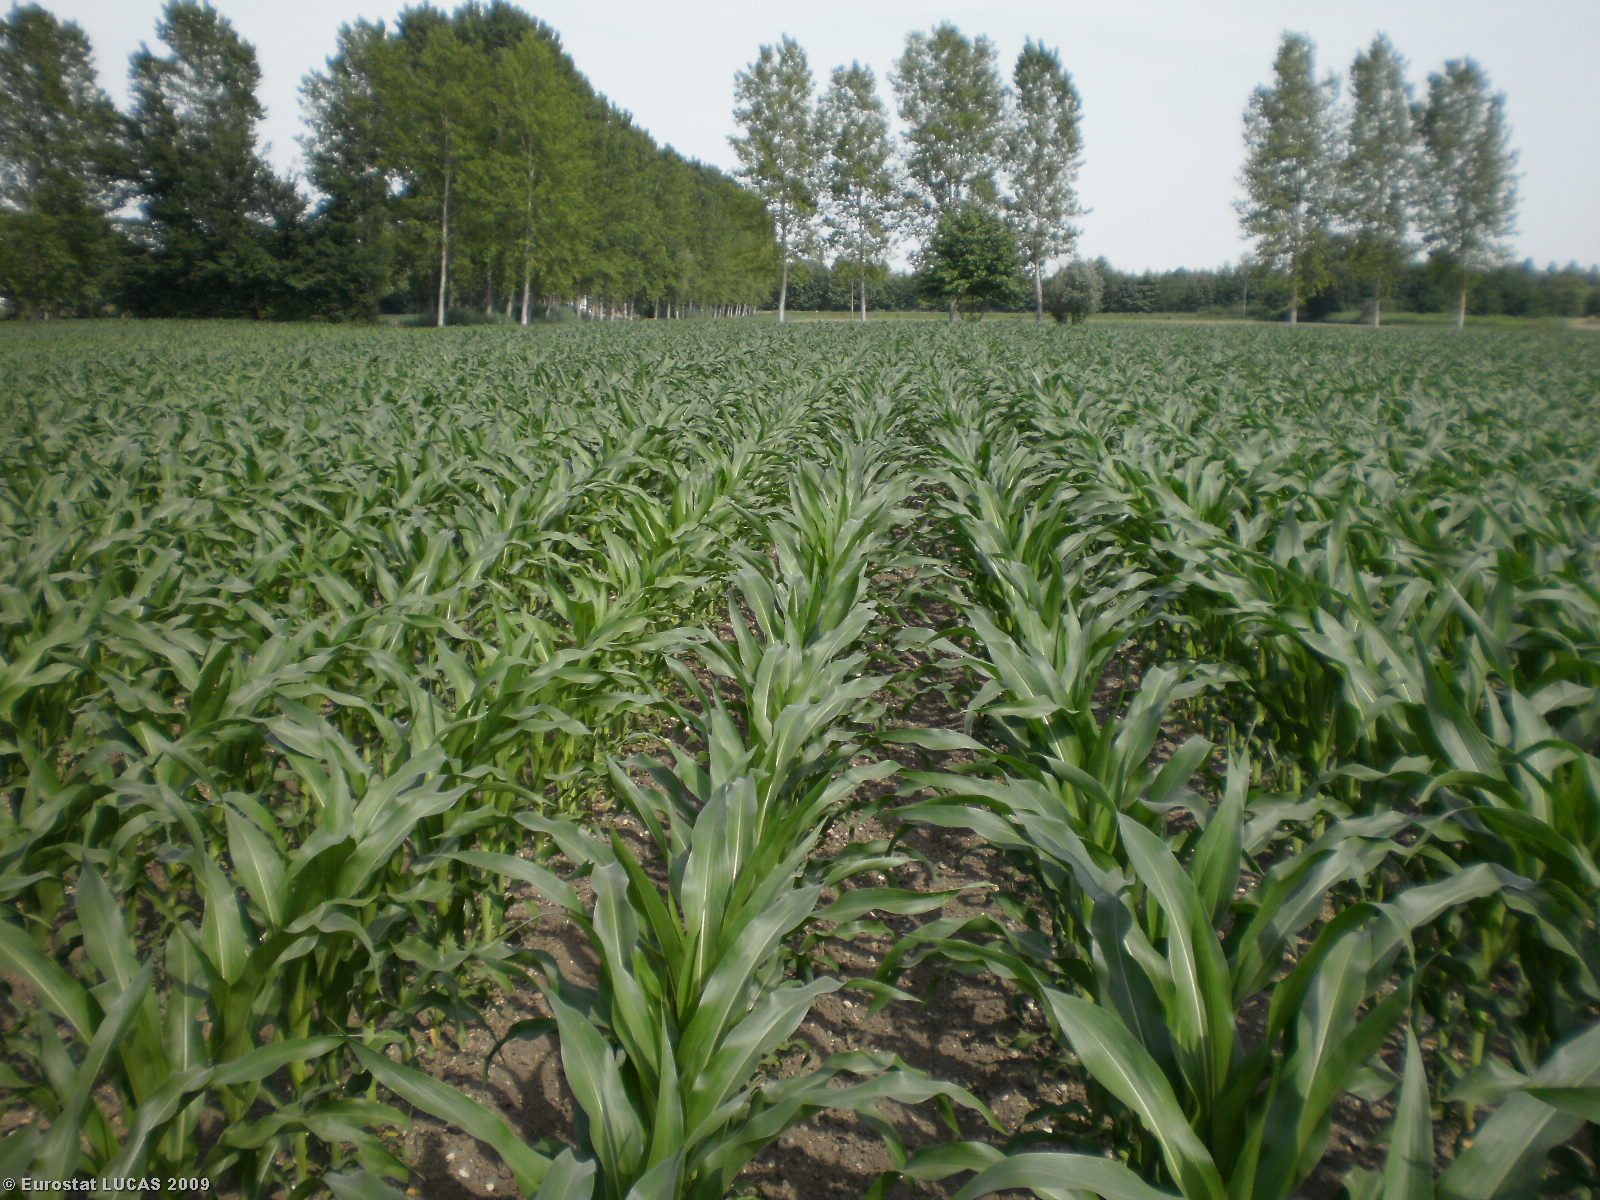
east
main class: Cropland
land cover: Maize
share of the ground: > 75 %
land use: Agriculture (excluding fallow land and kitchen gardens)
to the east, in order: Maize; Tracks; Grass margins; Inland running water; Grass margins; Broadleaved woodland; Tracks; Maize; Broadleaved woodland; Maize
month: May
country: IT
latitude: 45.1771
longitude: 10.7748
